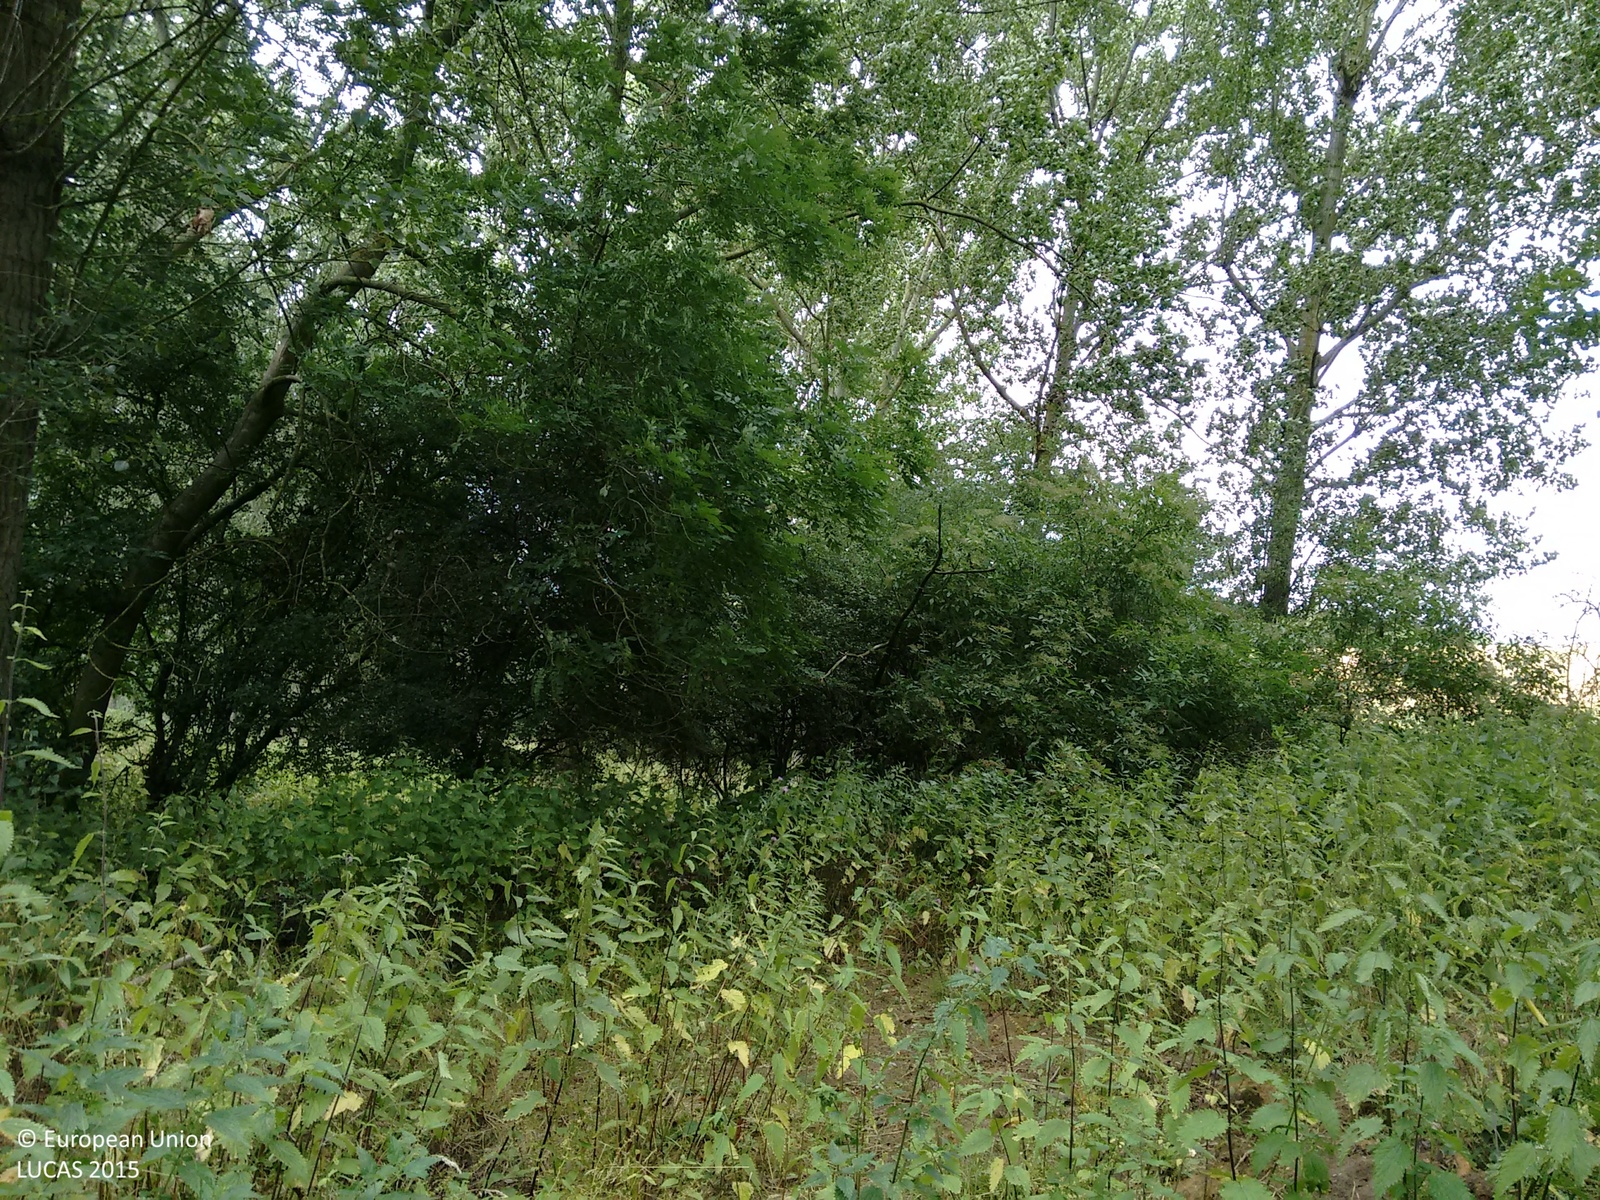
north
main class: Woodland
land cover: Broadleaved woodland
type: mesophytic deciduous forest
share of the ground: > 75 %
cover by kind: broadleaved forest trees 90 %, shrubs 5 %, herbaceous plants 5 %
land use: Semi-natural and natural areas not in use
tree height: > 5 m
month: July
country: GB
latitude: 51.6899
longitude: 0.0879
